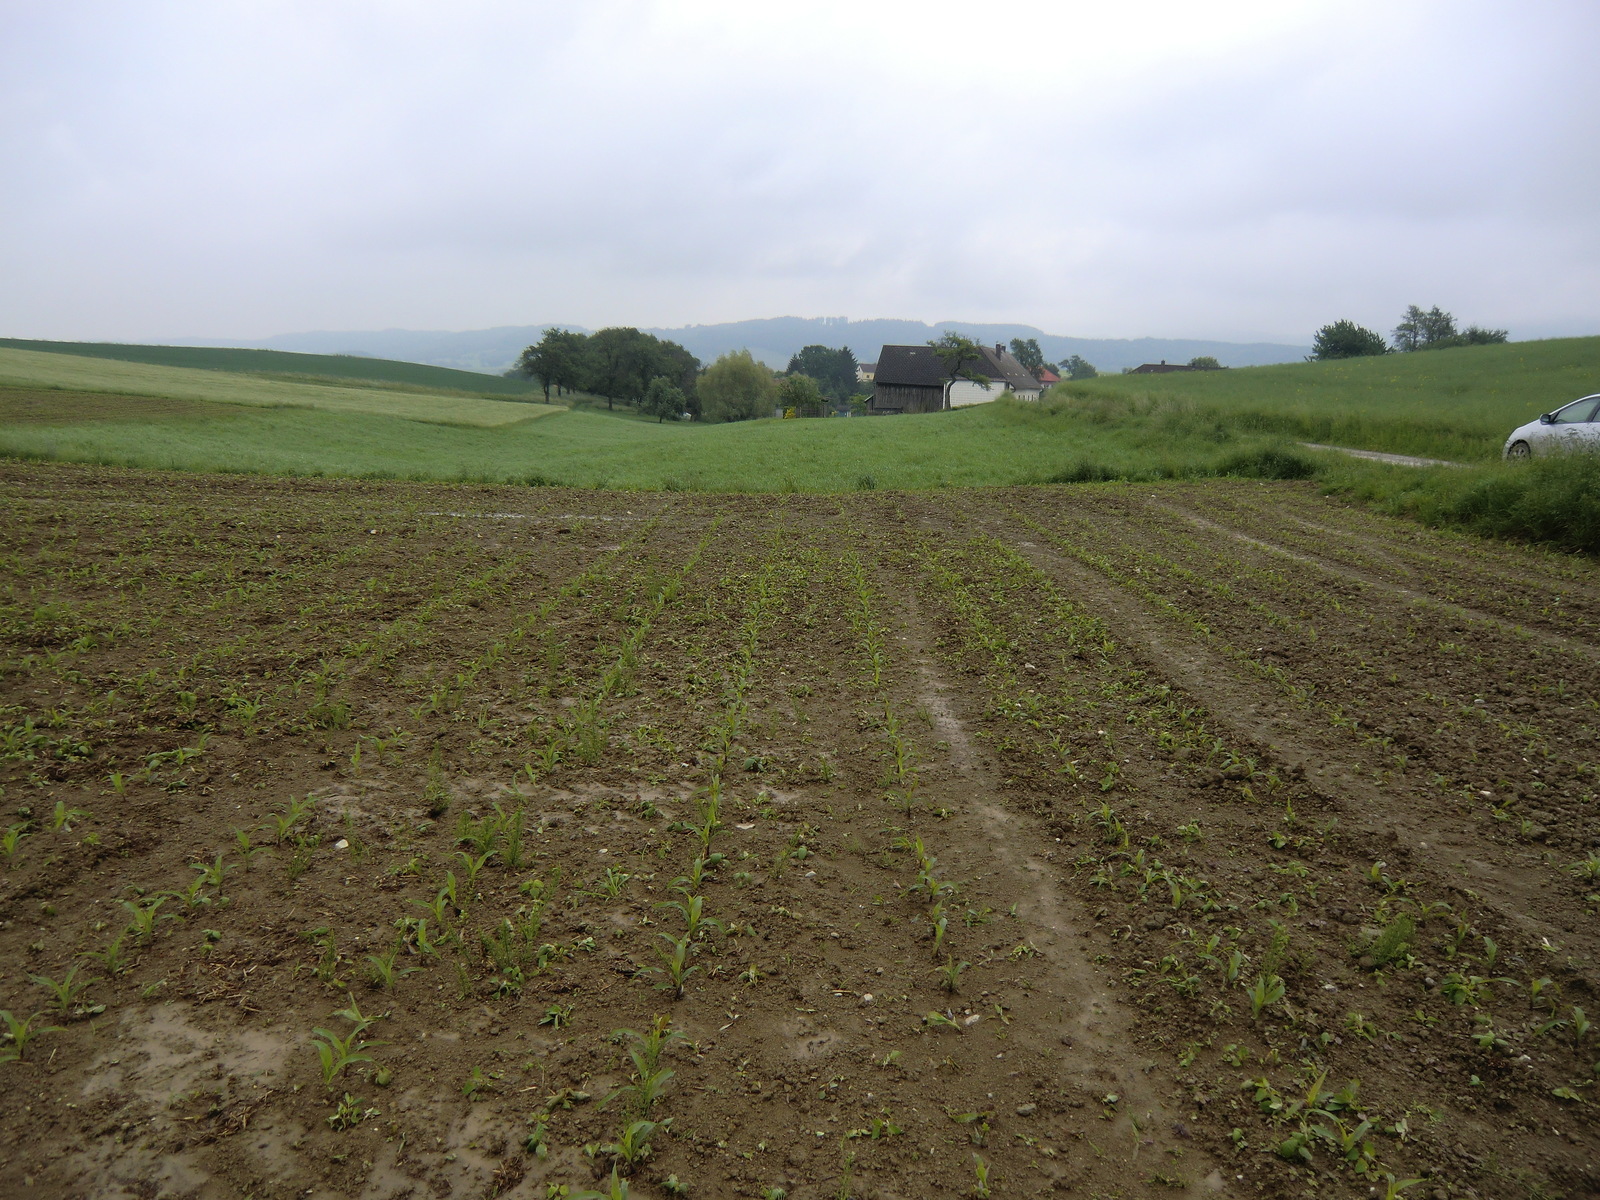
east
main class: Cropland
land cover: Maize
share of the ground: 10 - 25 %
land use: Agriculture (excluding fallow land and kitchen gardens)
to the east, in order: Maize; Grassland without tree/shrub cover; Maize; Grass margins; Barley; Tracks; Common wheat
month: May
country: AT
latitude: 48.1099
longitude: 15.3877
